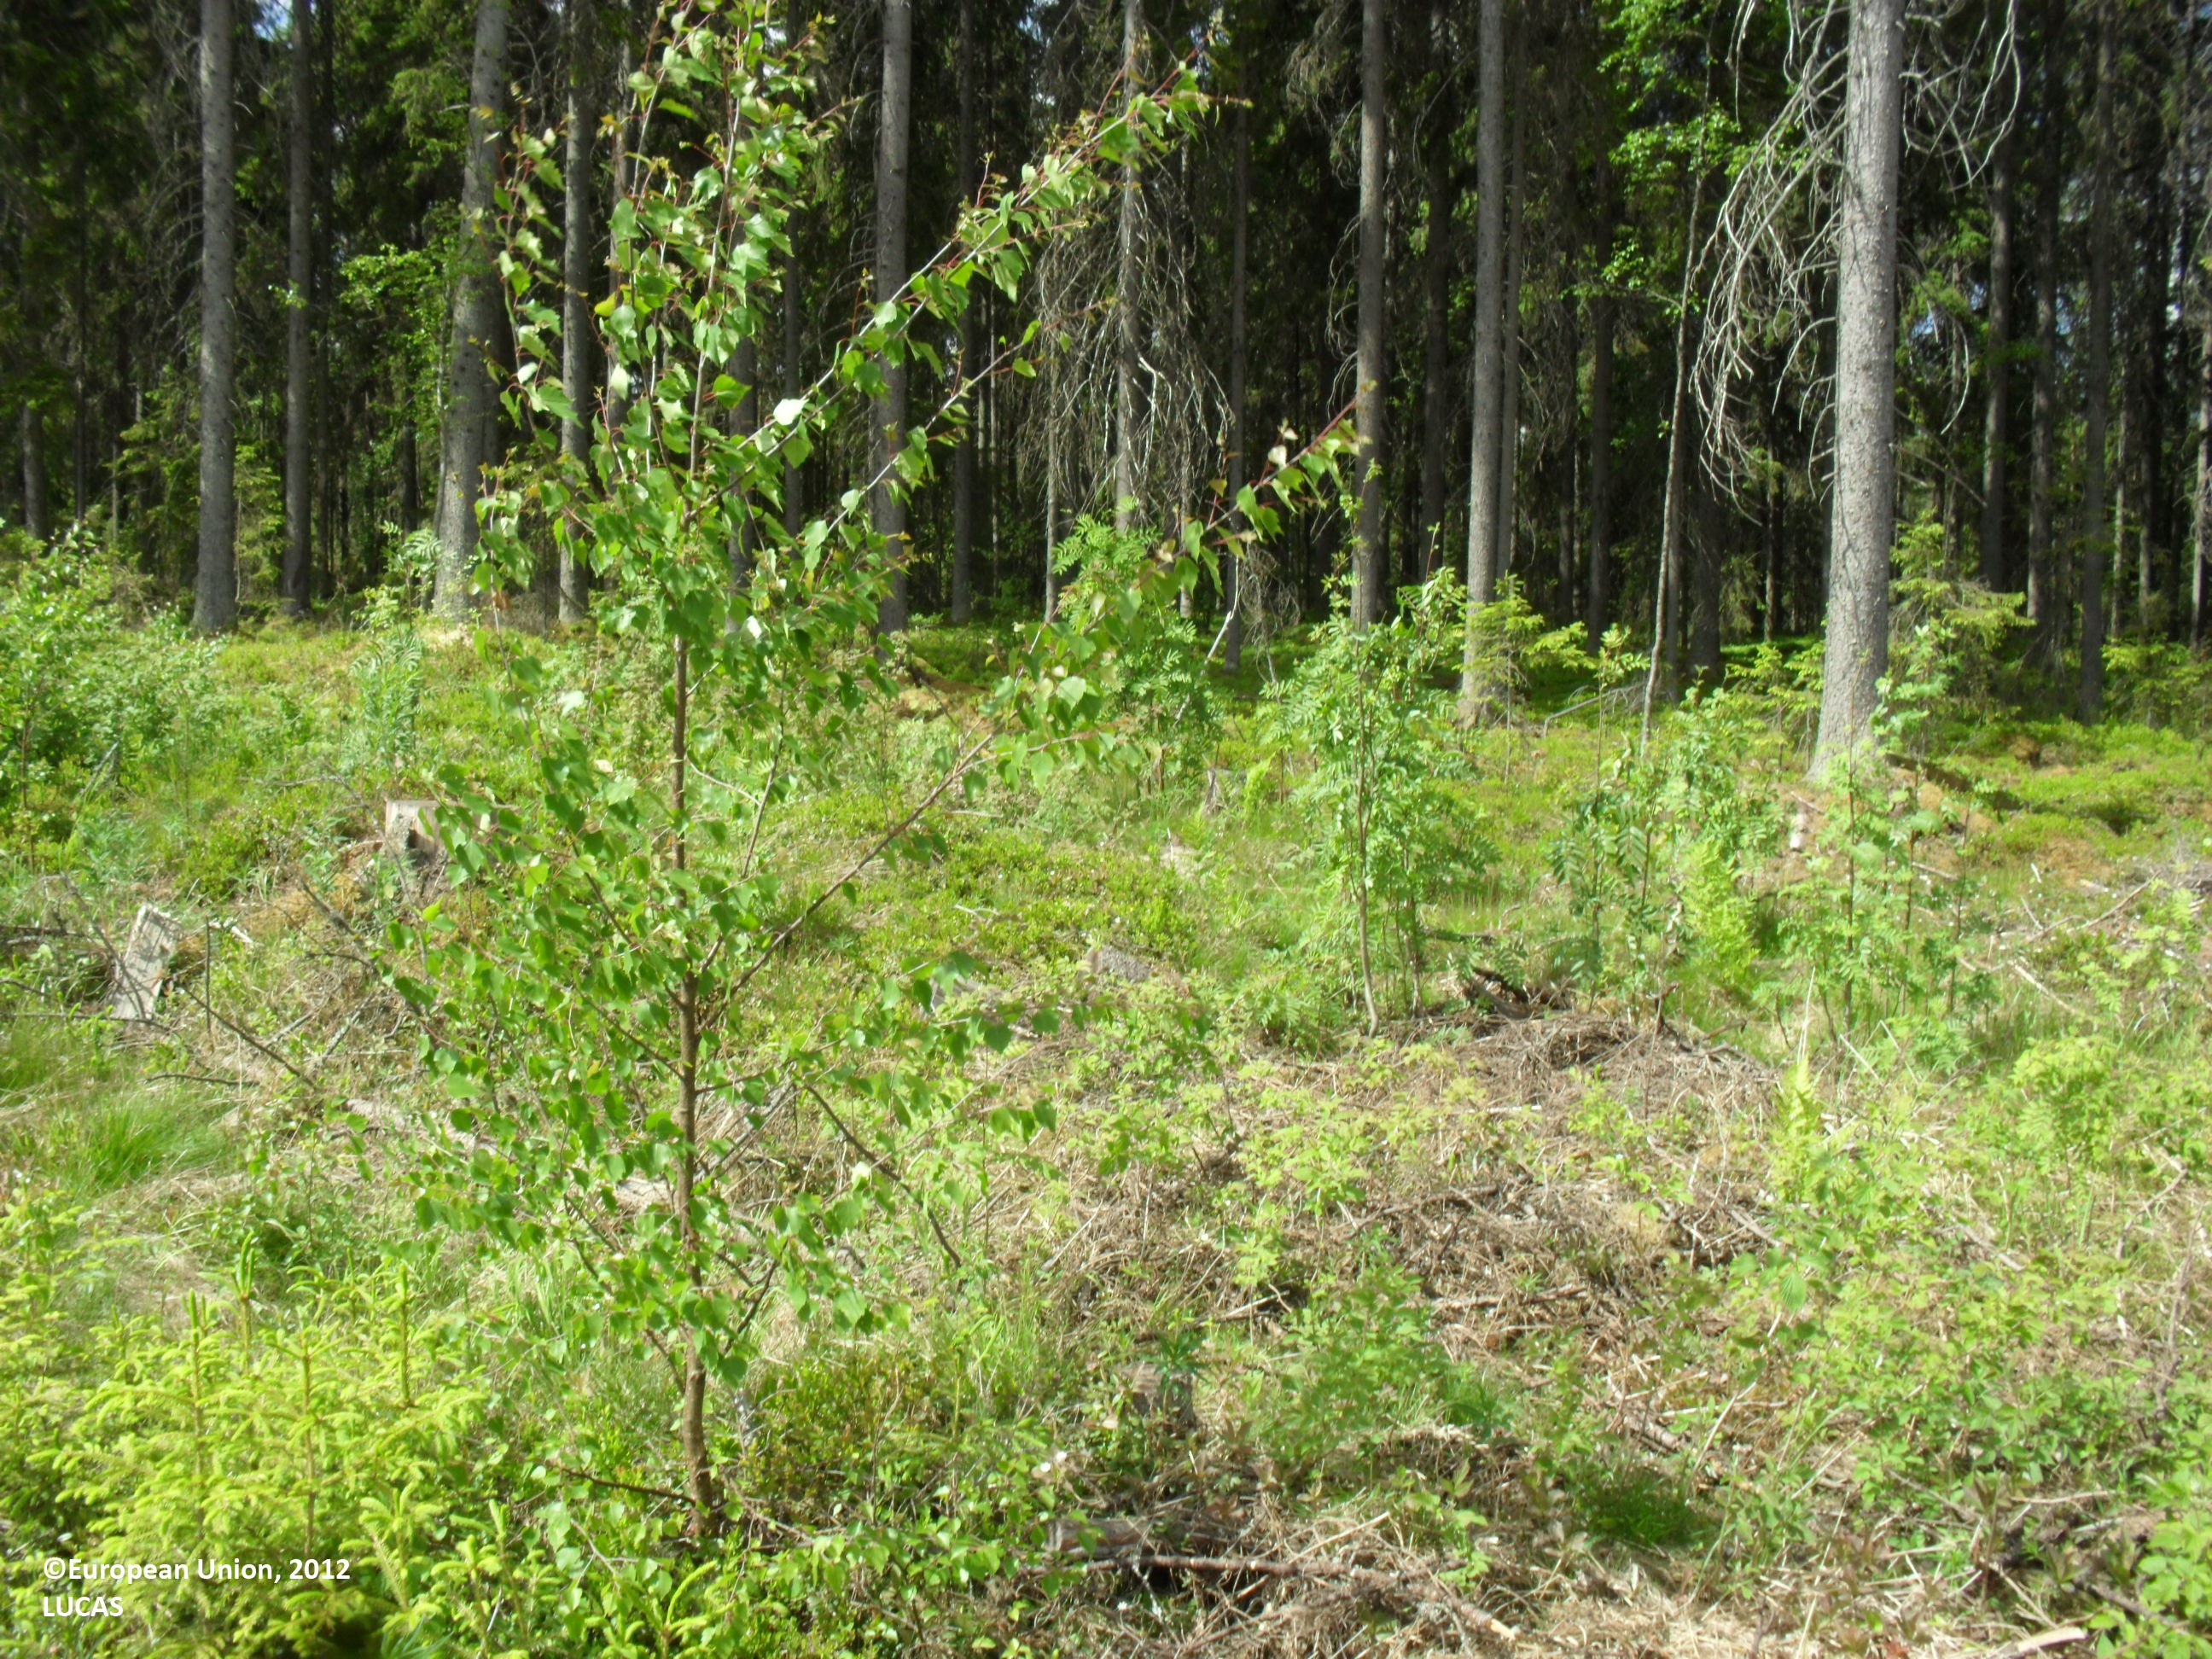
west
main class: Grassland
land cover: Grassland with sparse tree/shrub cover
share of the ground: < 10 %
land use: Forestry
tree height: < 5 m
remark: Clear cut
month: June
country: FI
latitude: 62.7934
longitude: 23.4582
